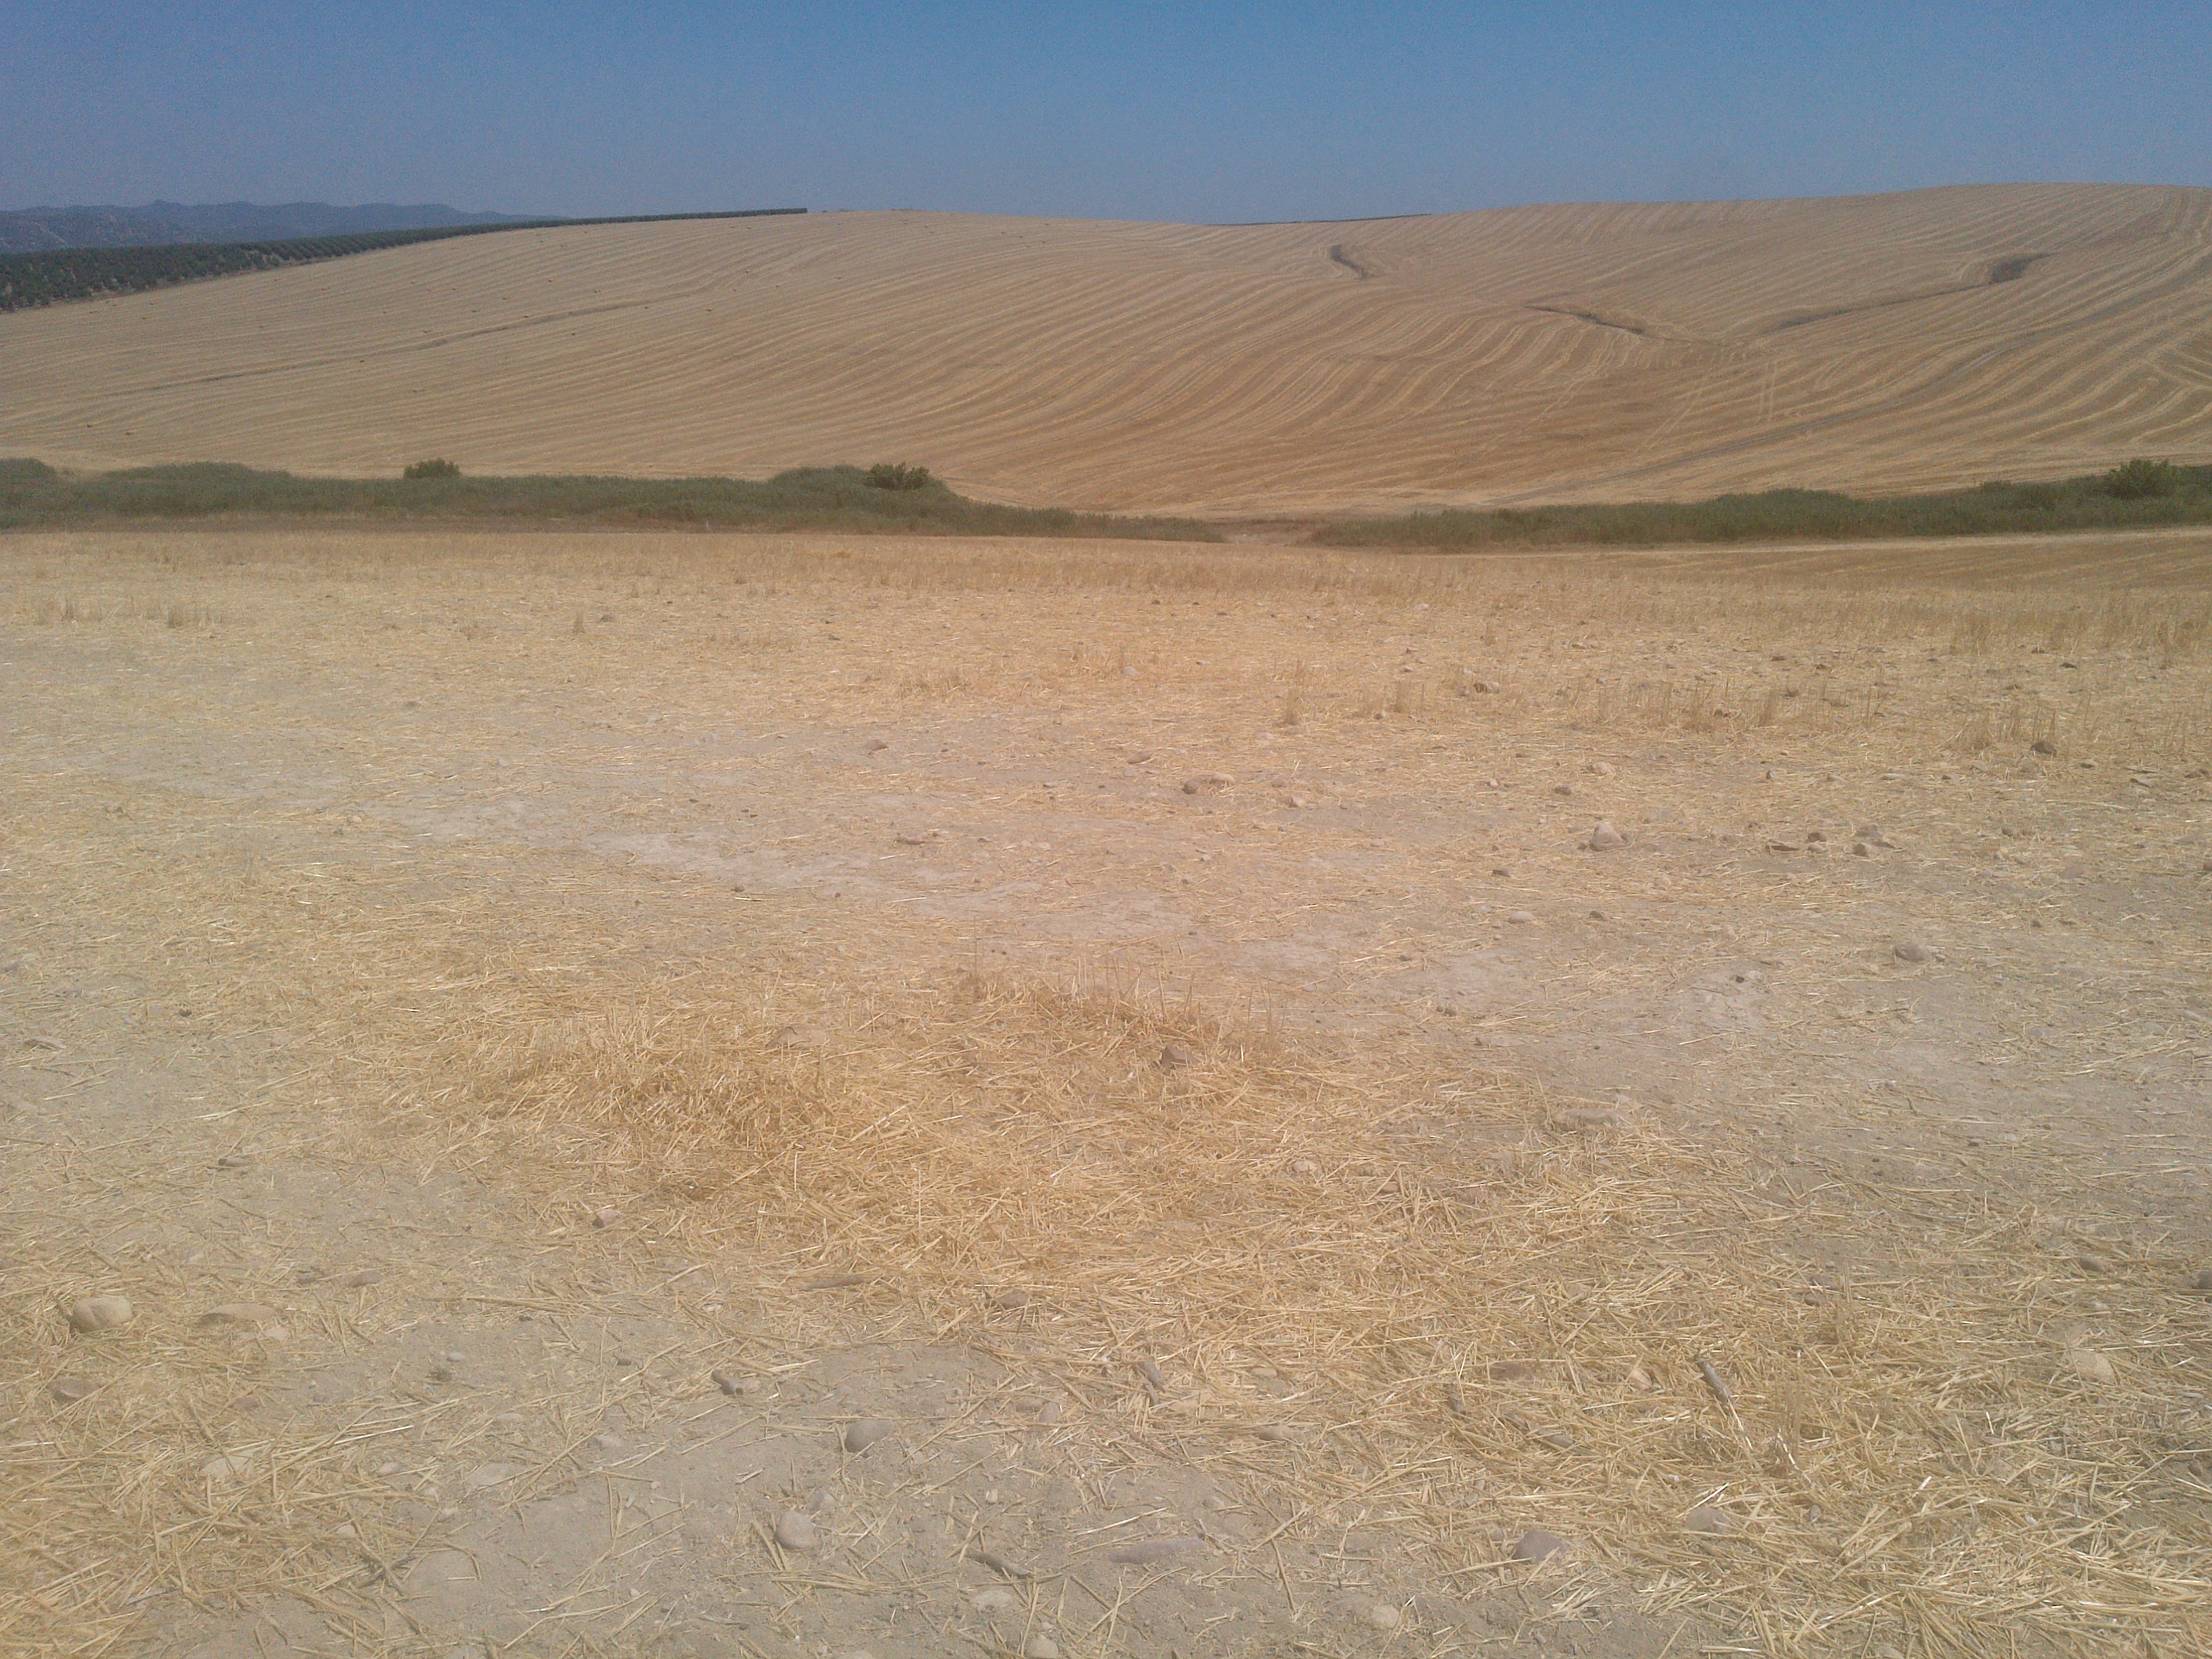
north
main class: Cropland
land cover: Durum wheat
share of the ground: < 10 %
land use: Agriculture (excluding fallow land and kitchen gardens)
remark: Harvested field
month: June
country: ES
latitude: 37.7916
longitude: -4.9481
